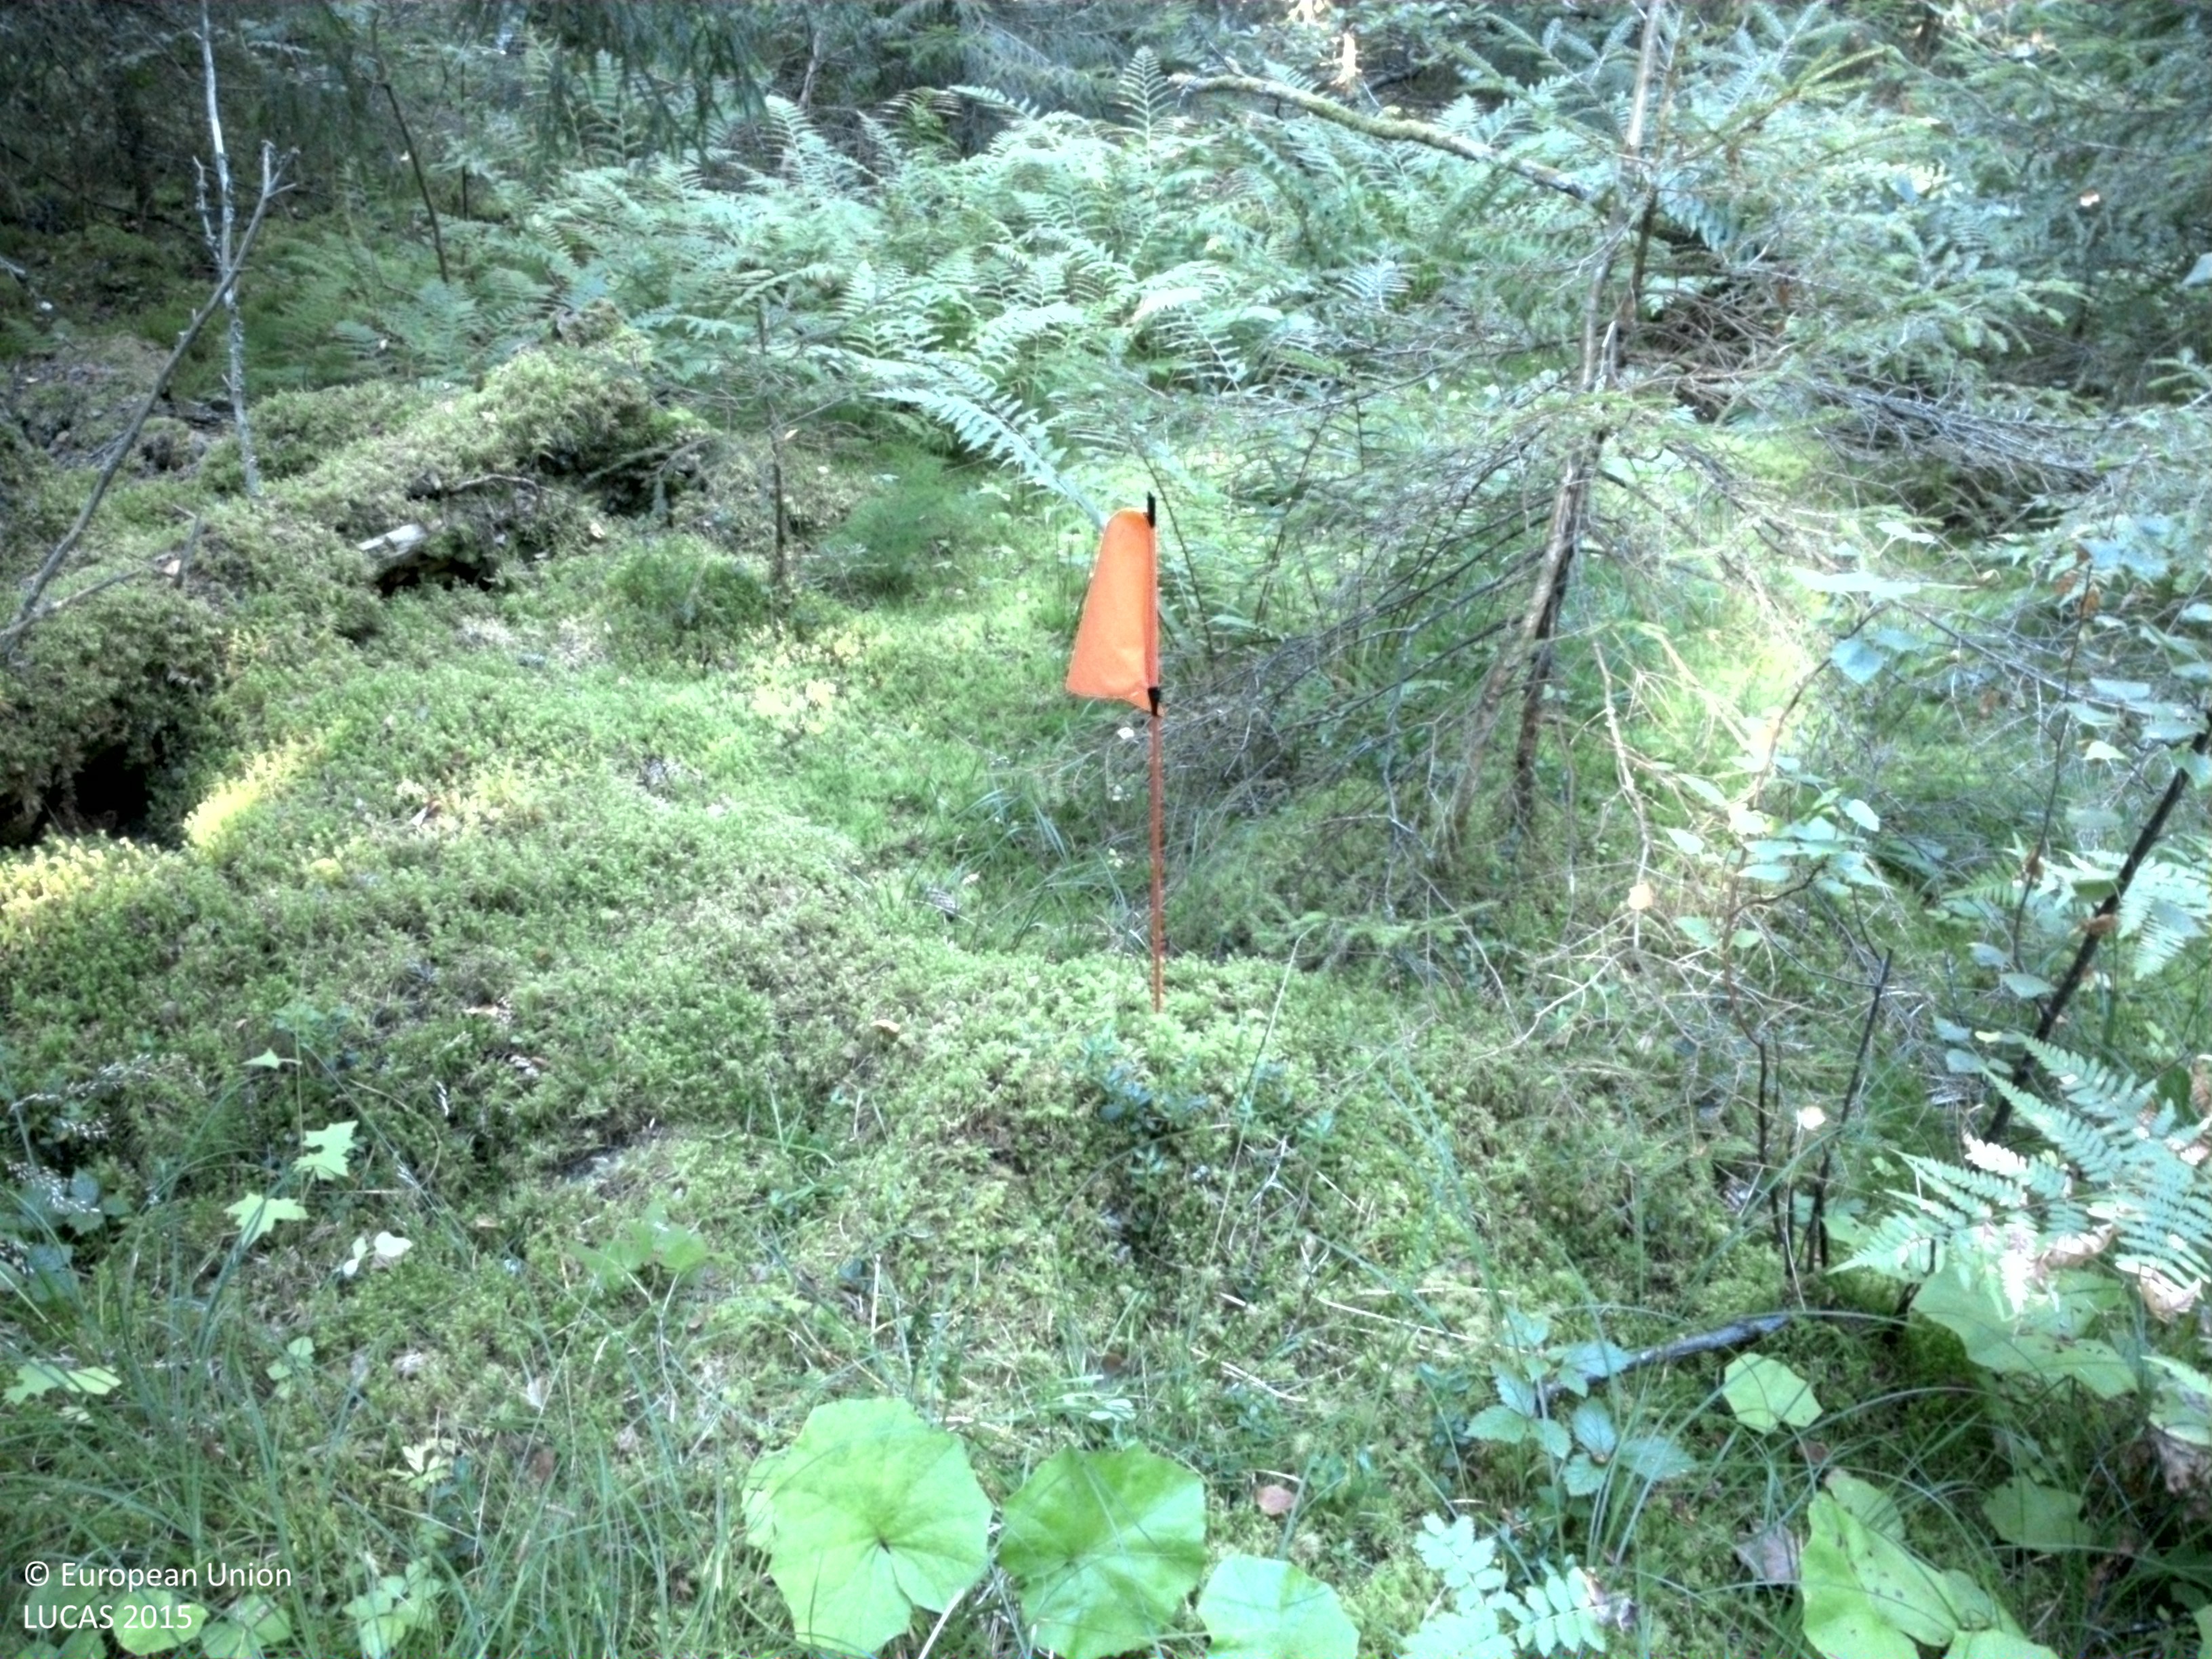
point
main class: Woodland
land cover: Spruce dominated coniferous woodland
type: boreal forest
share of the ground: > 75 %
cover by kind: coniferous forest trees 70 %, herbaceous plants 25 %, broadleaved forest trees 5 %
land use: Forestry
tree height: > 5 m
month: August
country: SE
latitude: 59.7311
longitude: 17.7680
